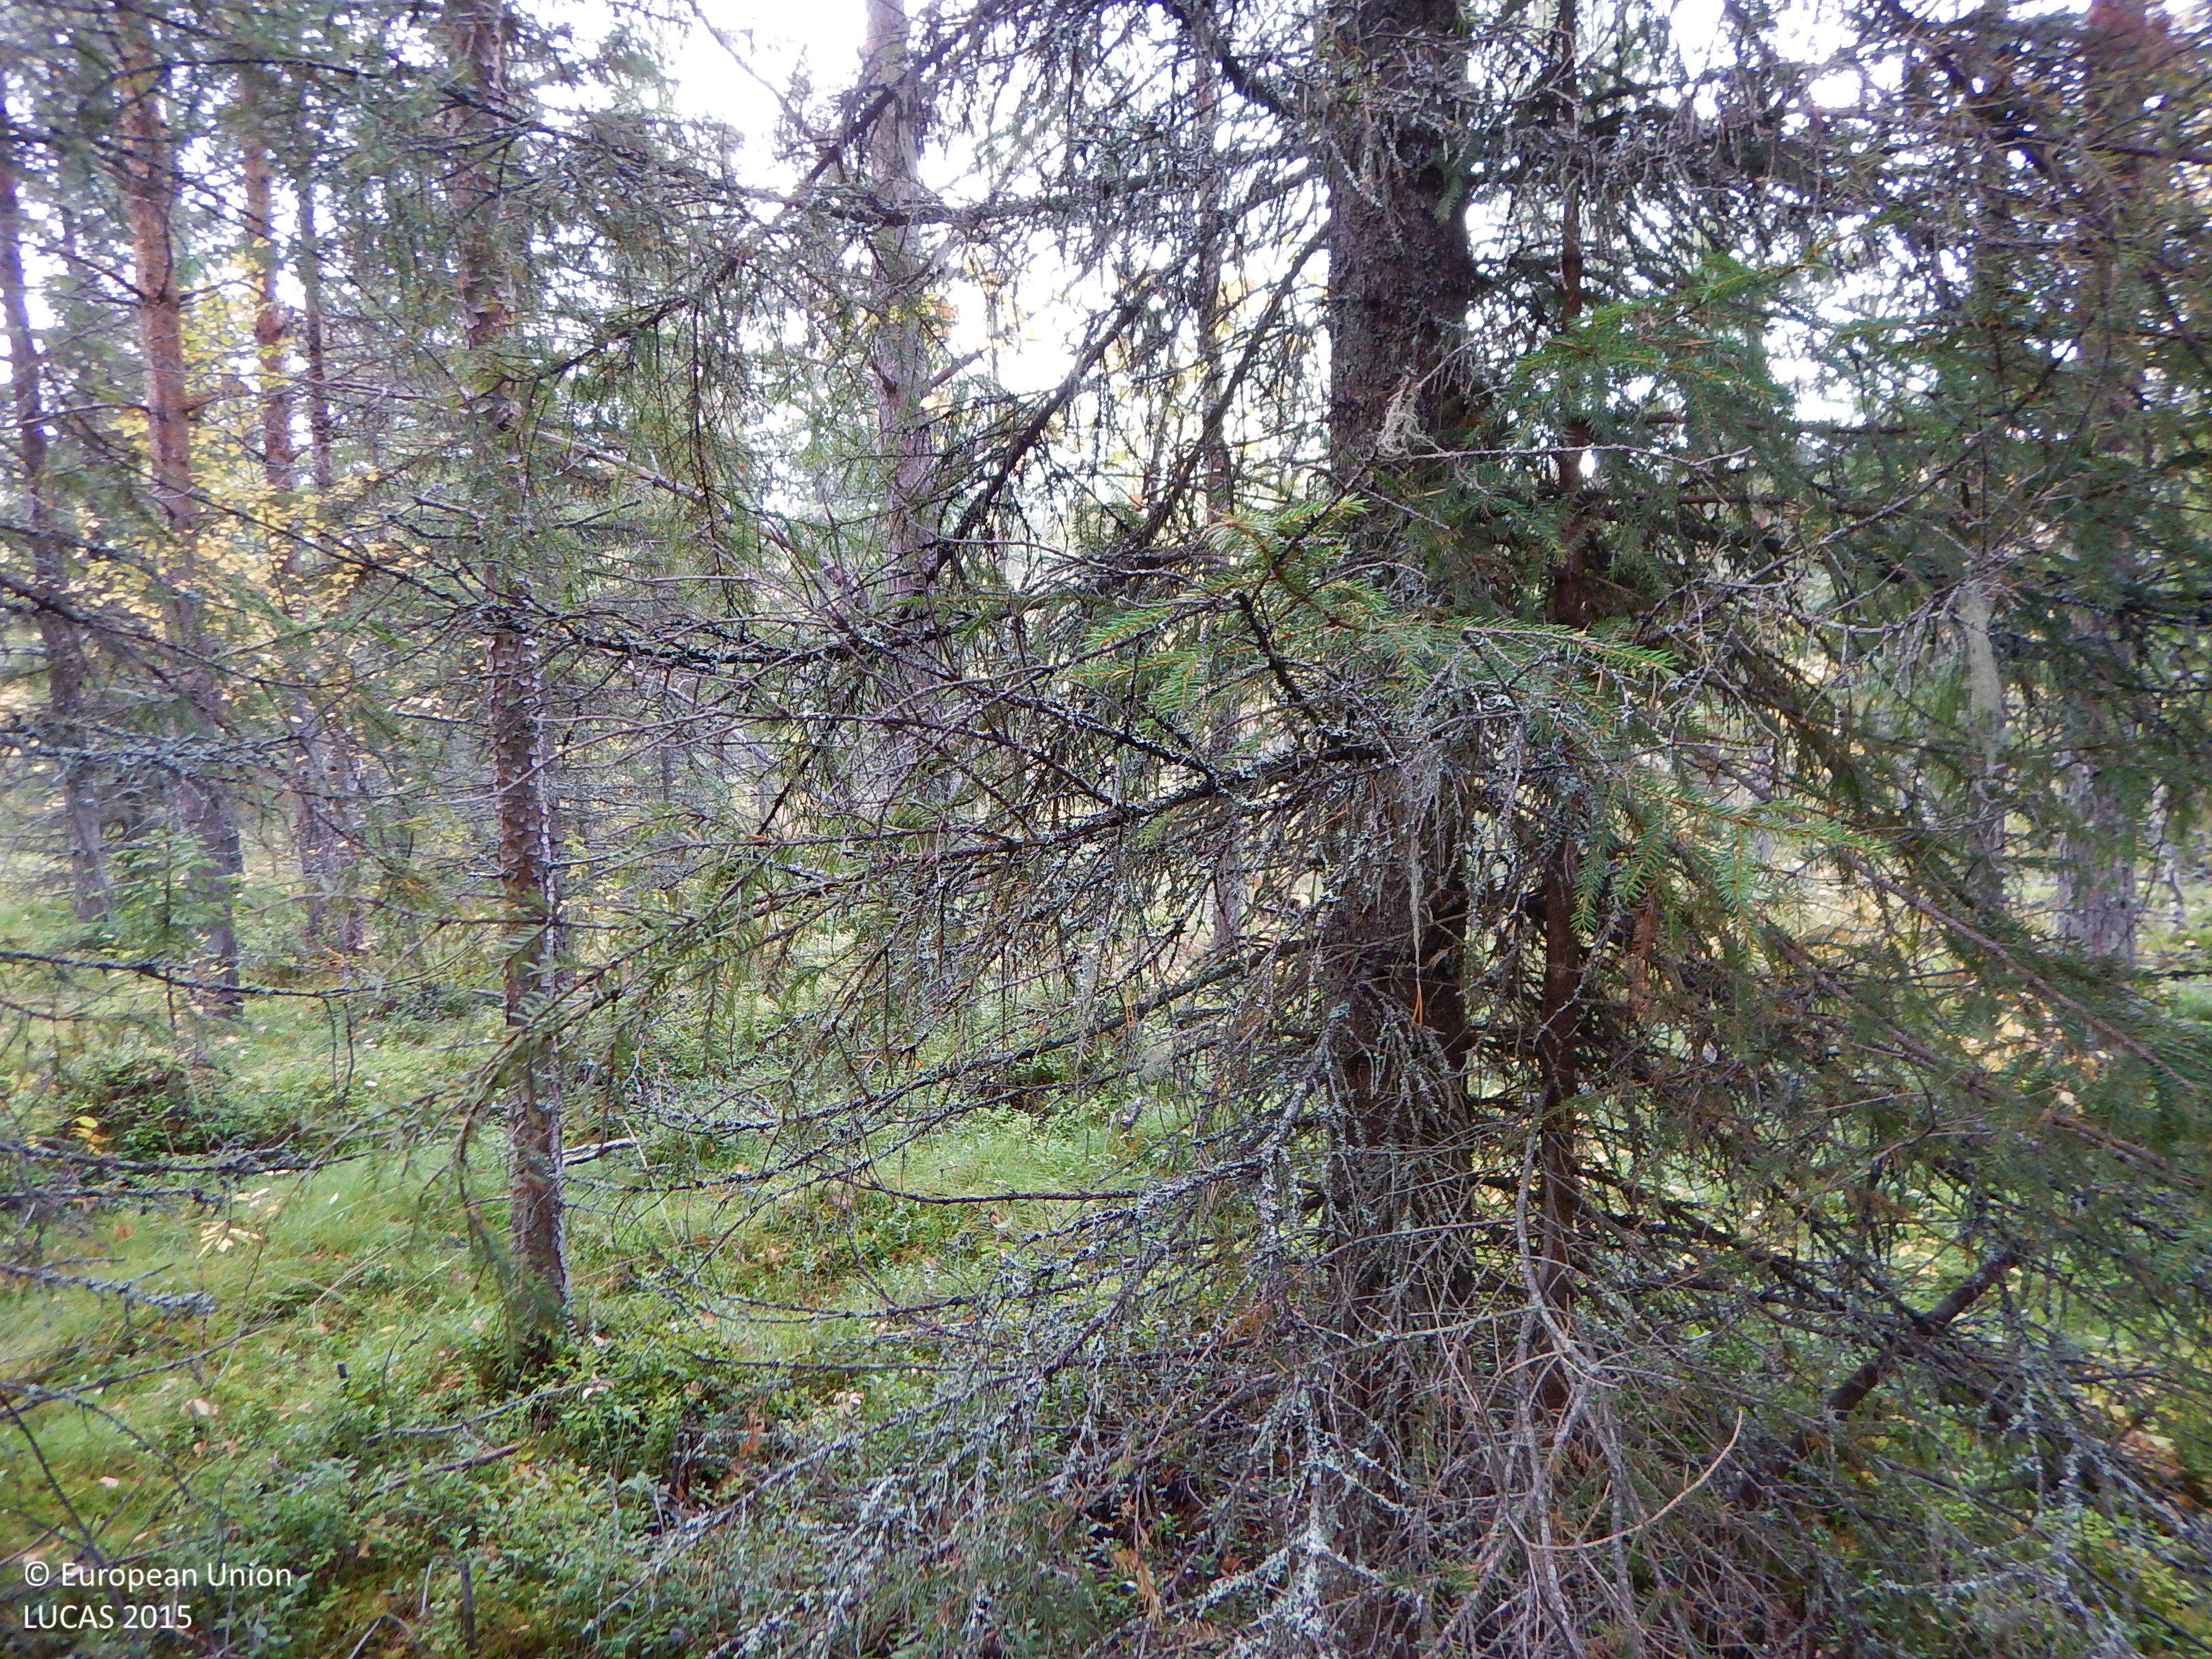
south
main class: Woodland
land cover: Other coniferous woodland
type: boreal forest
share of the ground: 50 - 75 %
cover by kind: coniferous forest trees 60 %, shrubs 15 %, herbaceous plants 10 %, lichens and mosses 10 %, broadleaved forest trees 5 %
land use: Forestry
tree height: > 5 m
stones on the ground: < 10 %
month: September
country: SE
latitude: 64.8001
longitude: 19.8850
